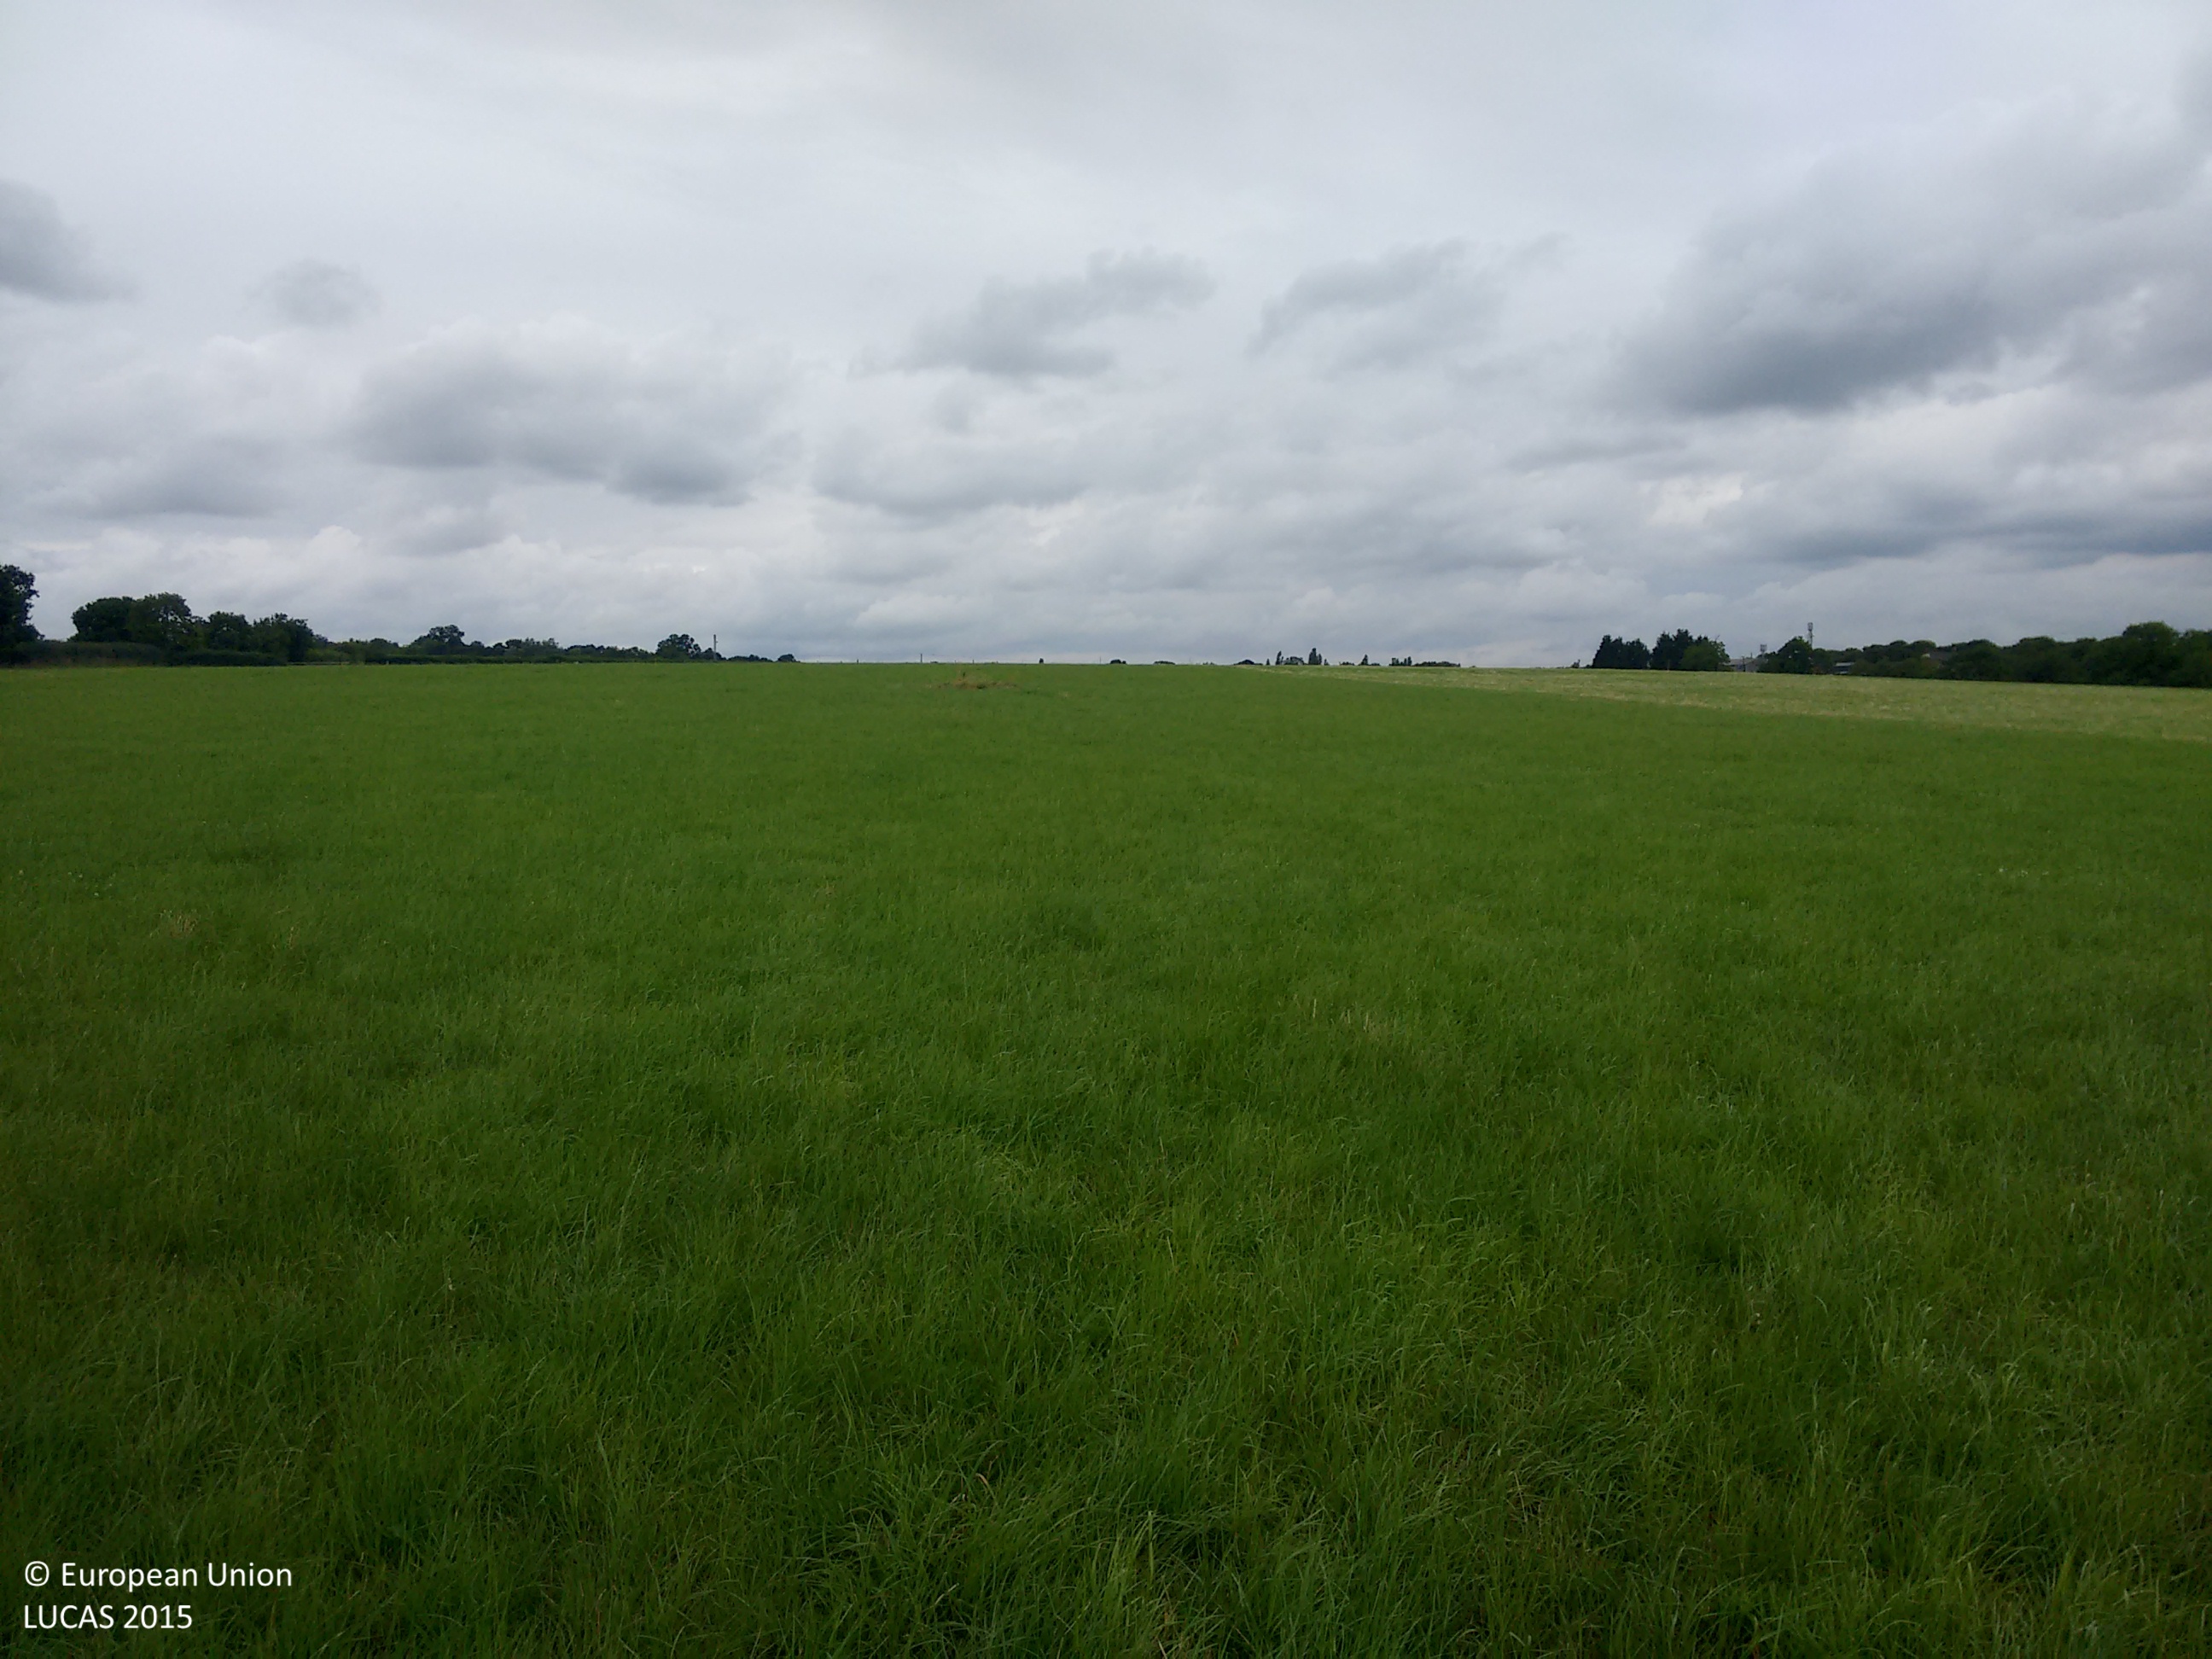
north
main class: Grassland
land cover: Grassland without tree/shrub cover
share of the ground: > 75 %
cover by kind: herbaceous plants 100 %
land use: Agriculture (excluding fallow land and kitchen gardens)
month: July
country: GB
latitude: 52.9071
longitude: -1.3035
